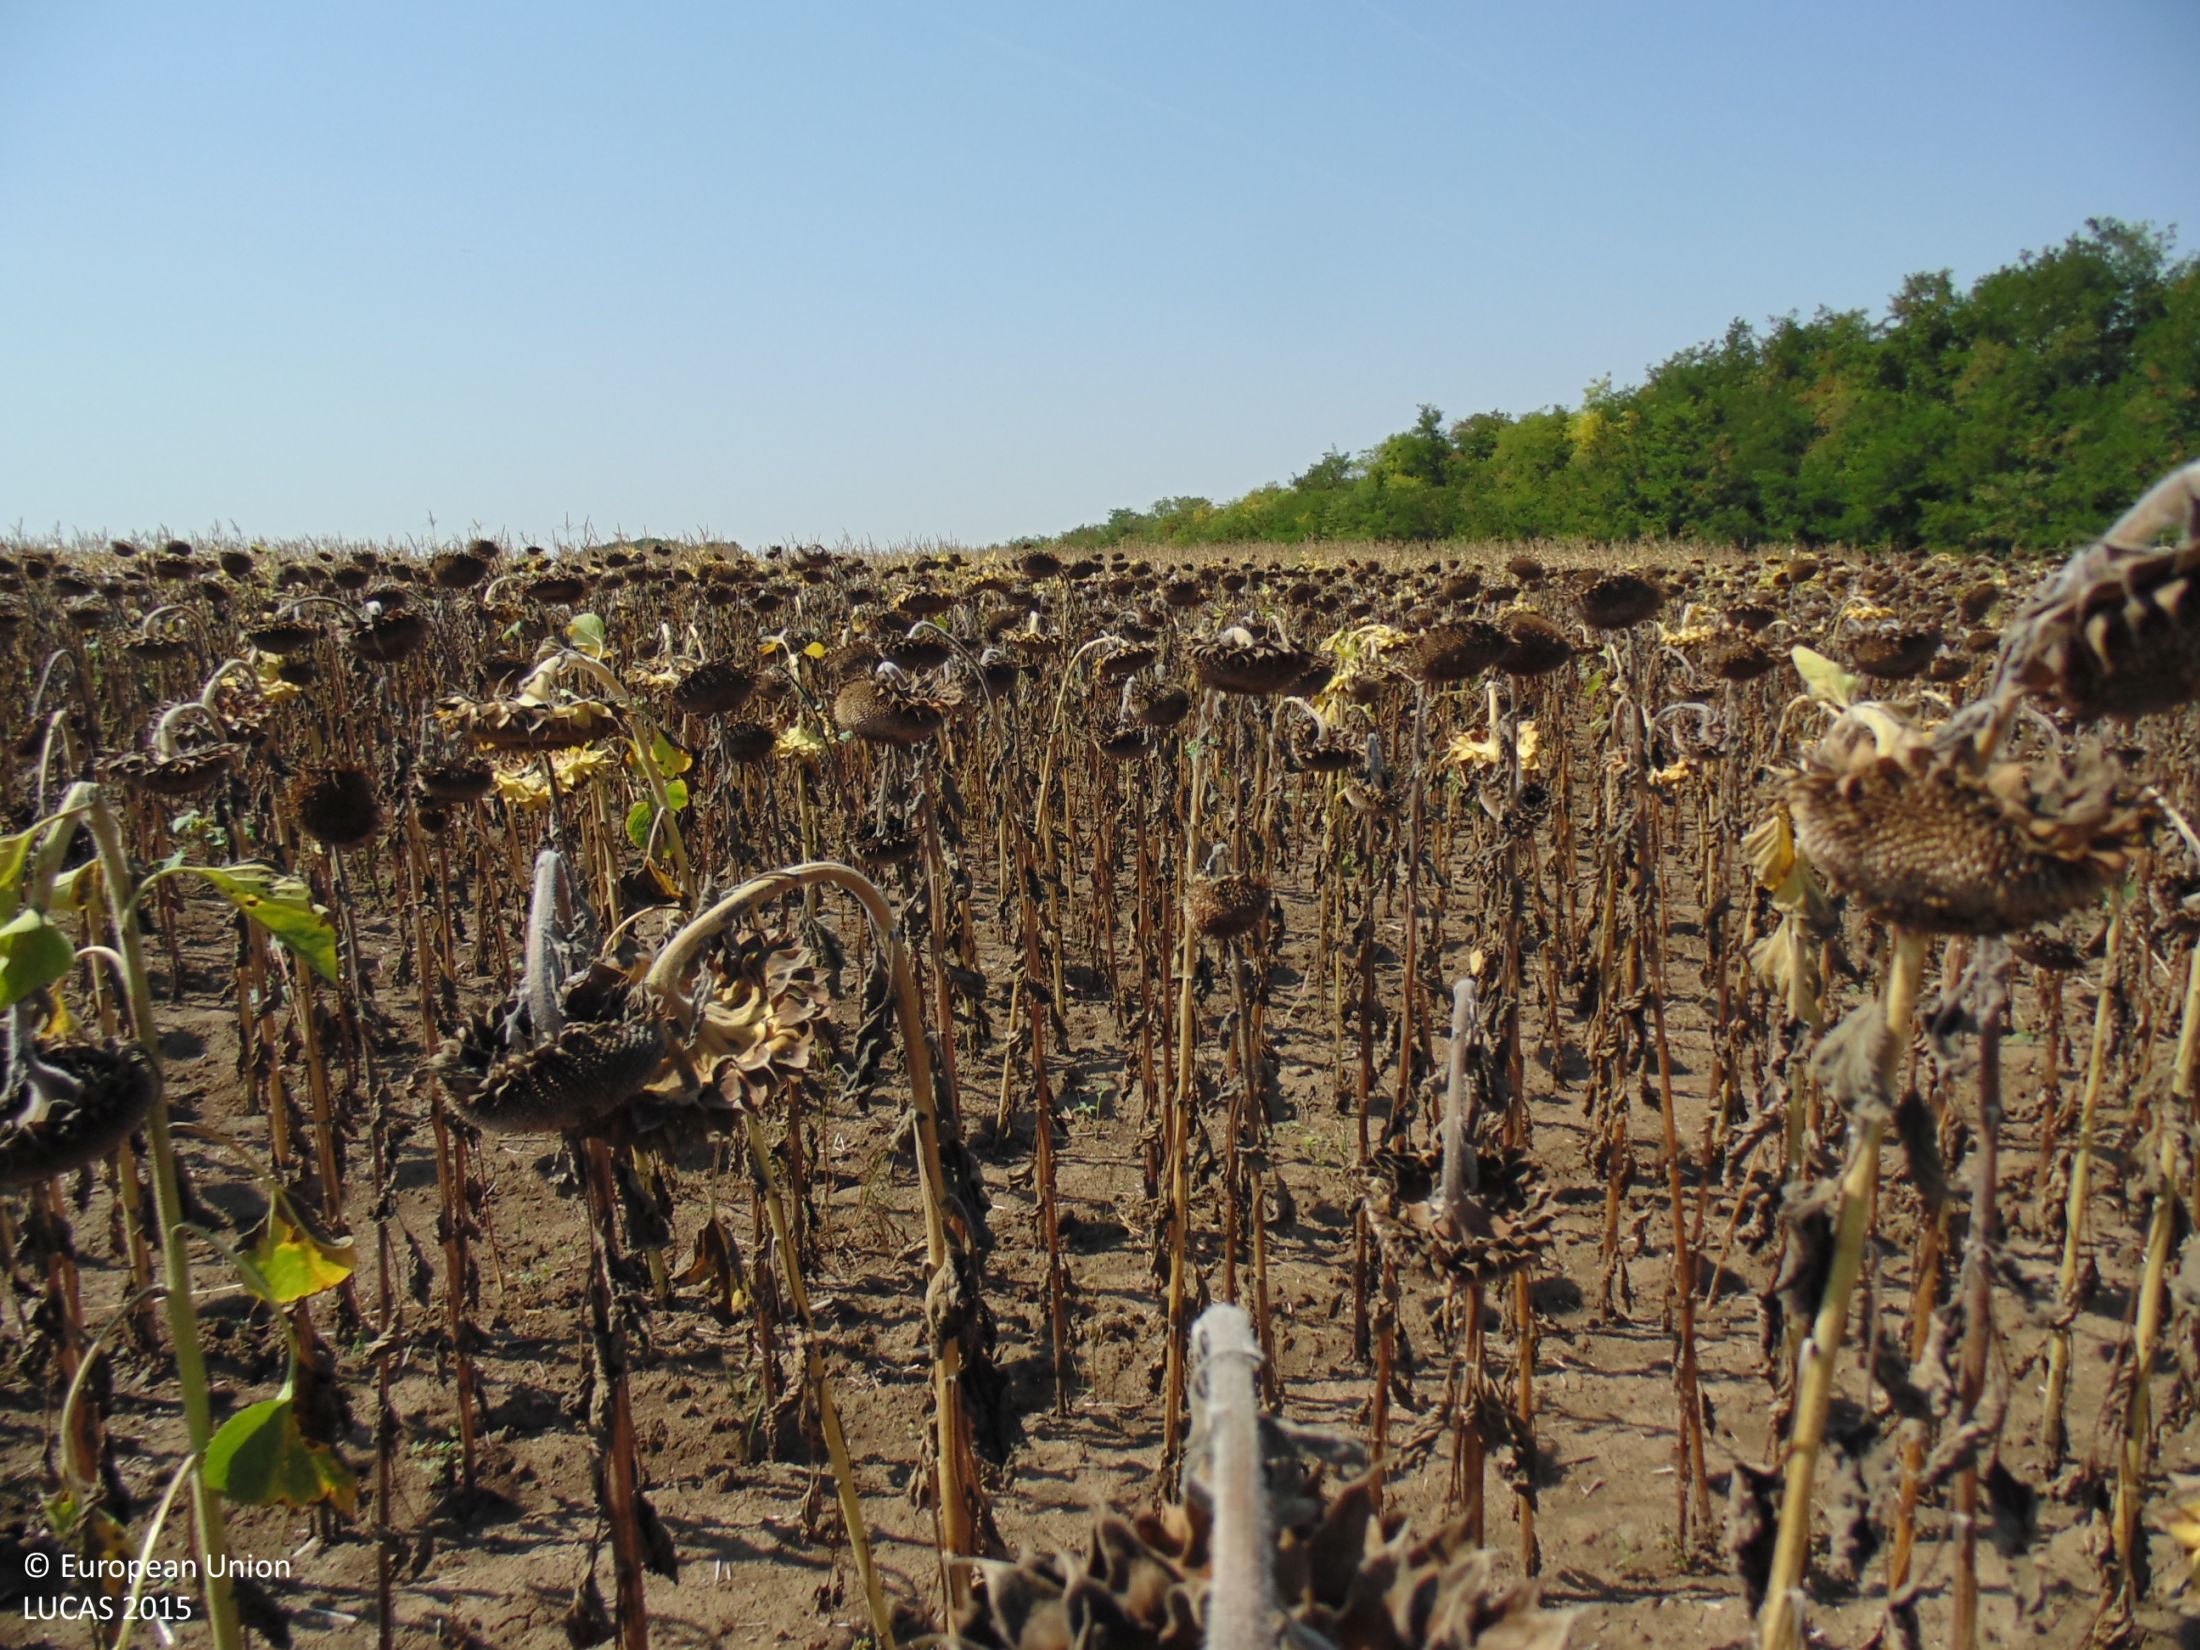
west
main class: Cropland
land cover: Sunflower
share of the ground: > 75 %
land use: Agriculture (excluding fallow land and kitchen gardens)
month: August
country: BG
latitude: 43.7239
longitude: 27.4491
